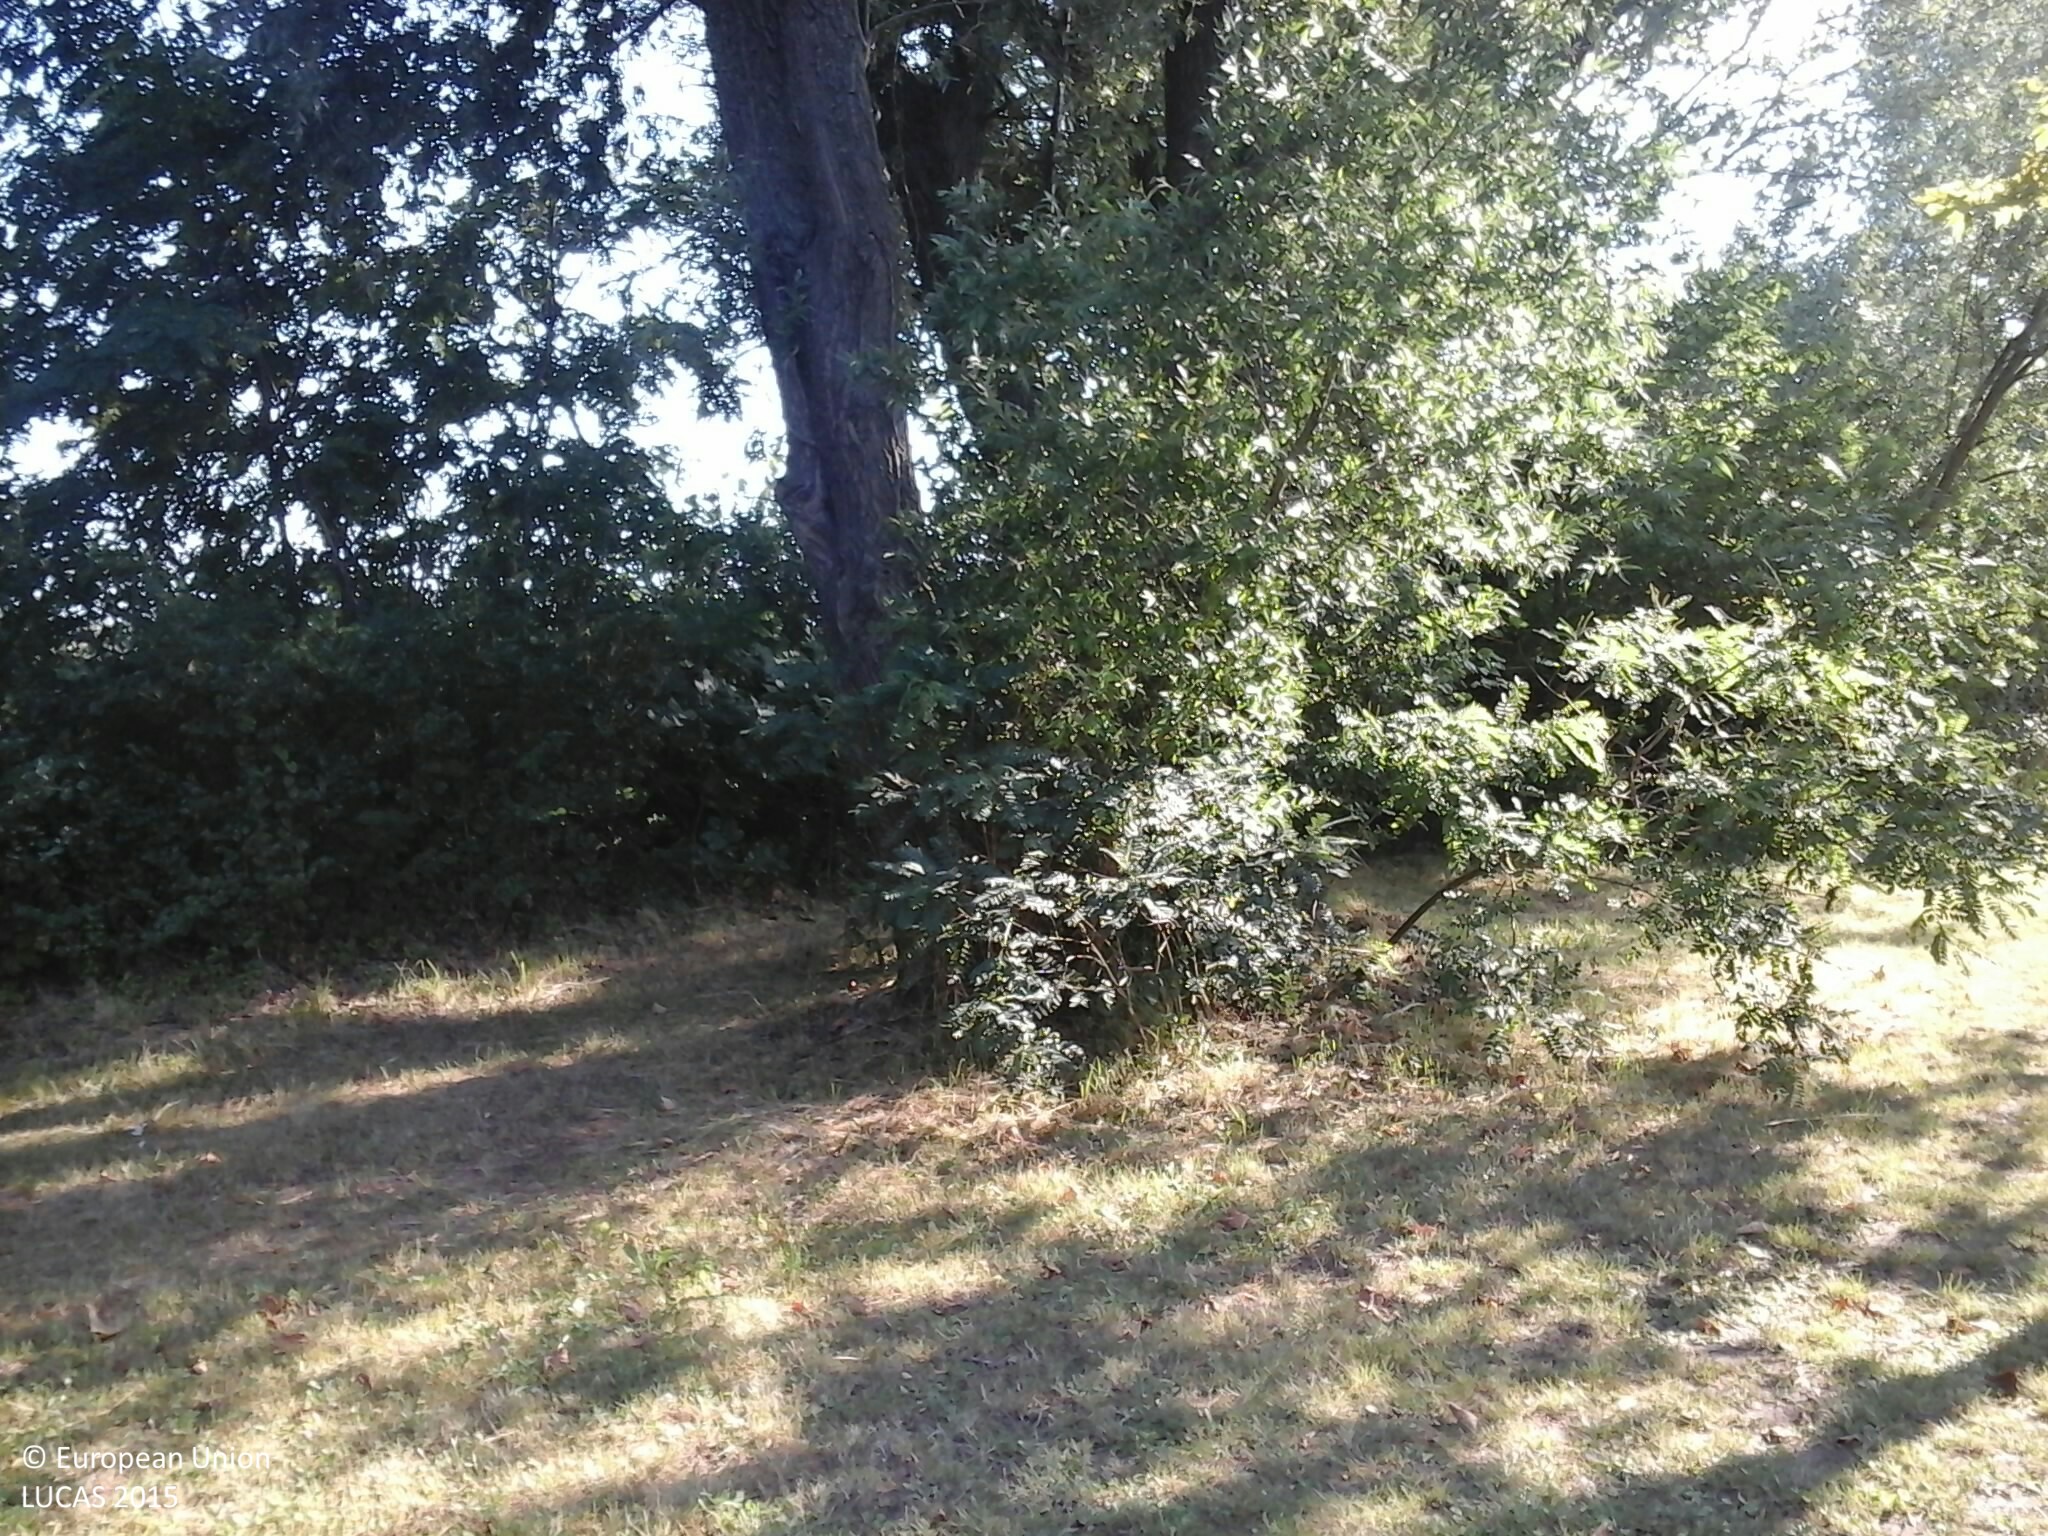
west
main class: Grassland
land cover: Grassland with sparse tree/shrub cover
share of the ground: > 75 %
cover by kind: herbaceous plants 90 %, broadleaved forest trees 5 %, shrubs 5 %
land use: Commerce
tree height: < 5 m
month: July
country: HU
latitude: 46.8828
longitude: 17.7629
